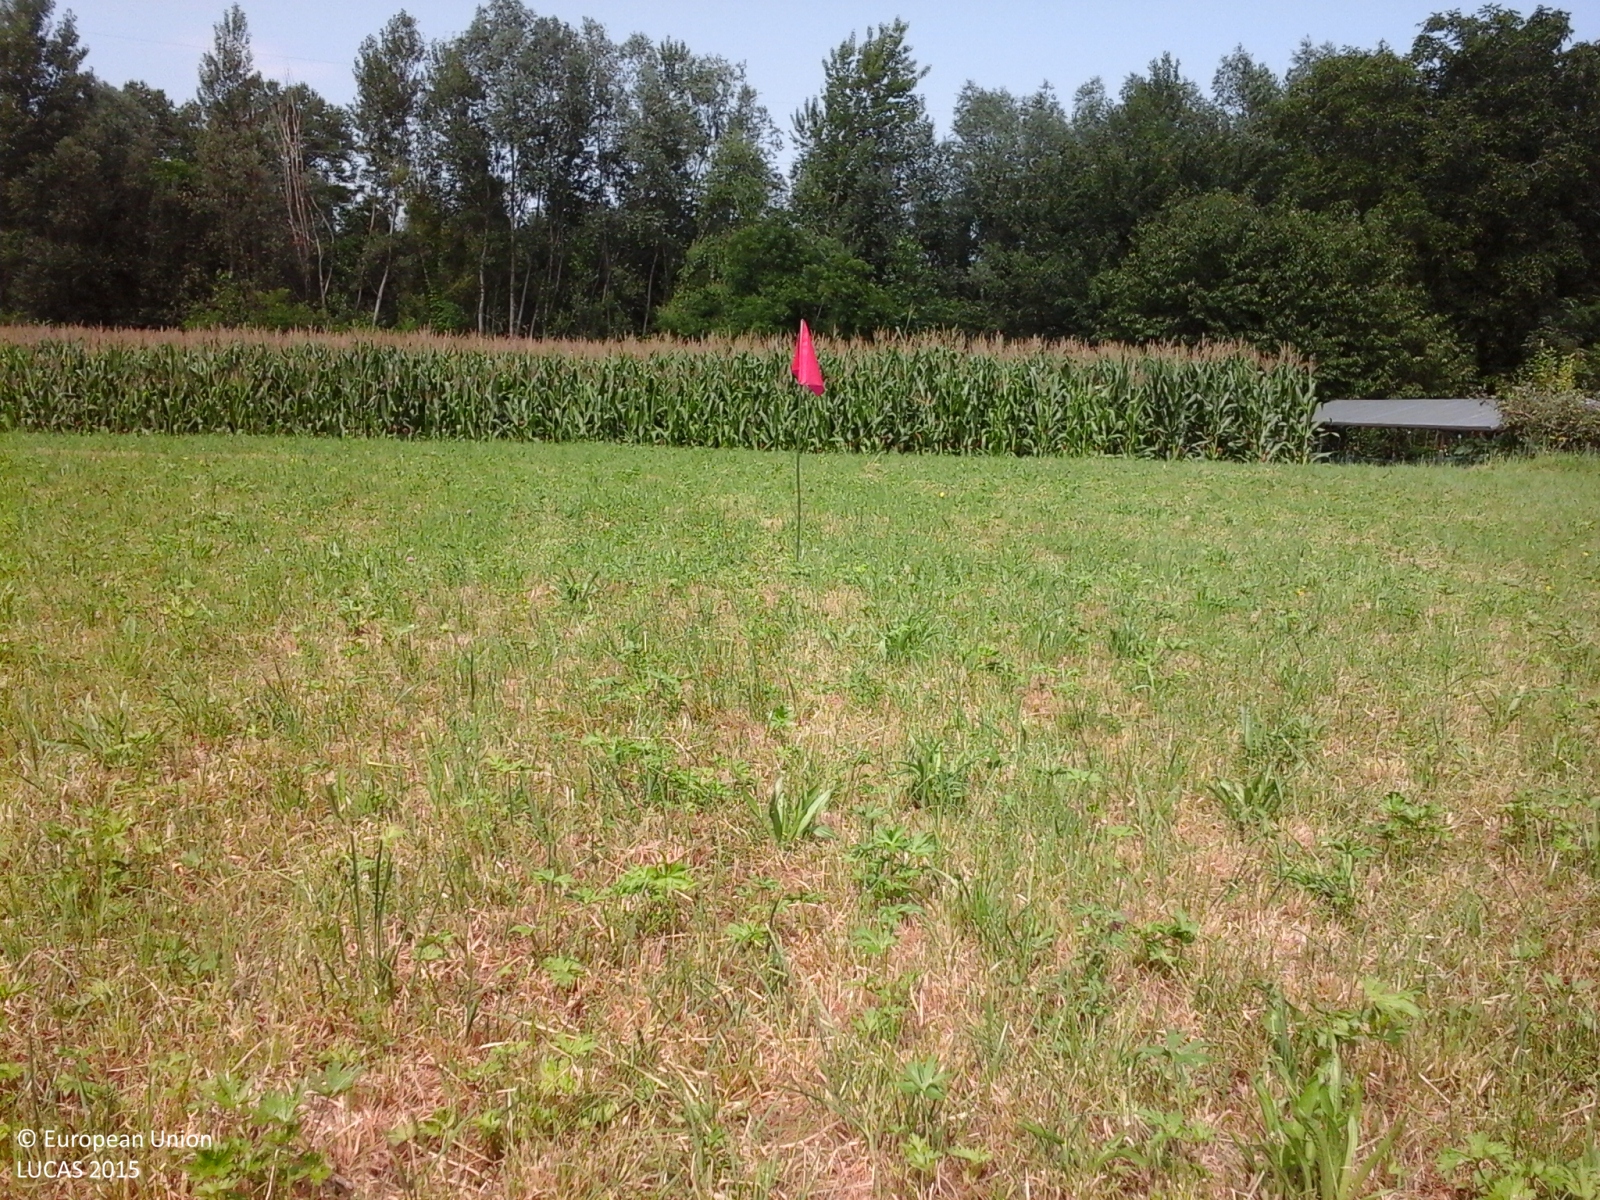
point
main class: Grassland
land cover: Grassland without tree/shrub cover
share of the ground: > 75 %
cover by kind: herbaceous plants 100 %
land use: Agriculture (excluding fallow land and kitchen gardens)
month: July
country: IT
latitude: 44.8750
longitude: 7.3086
